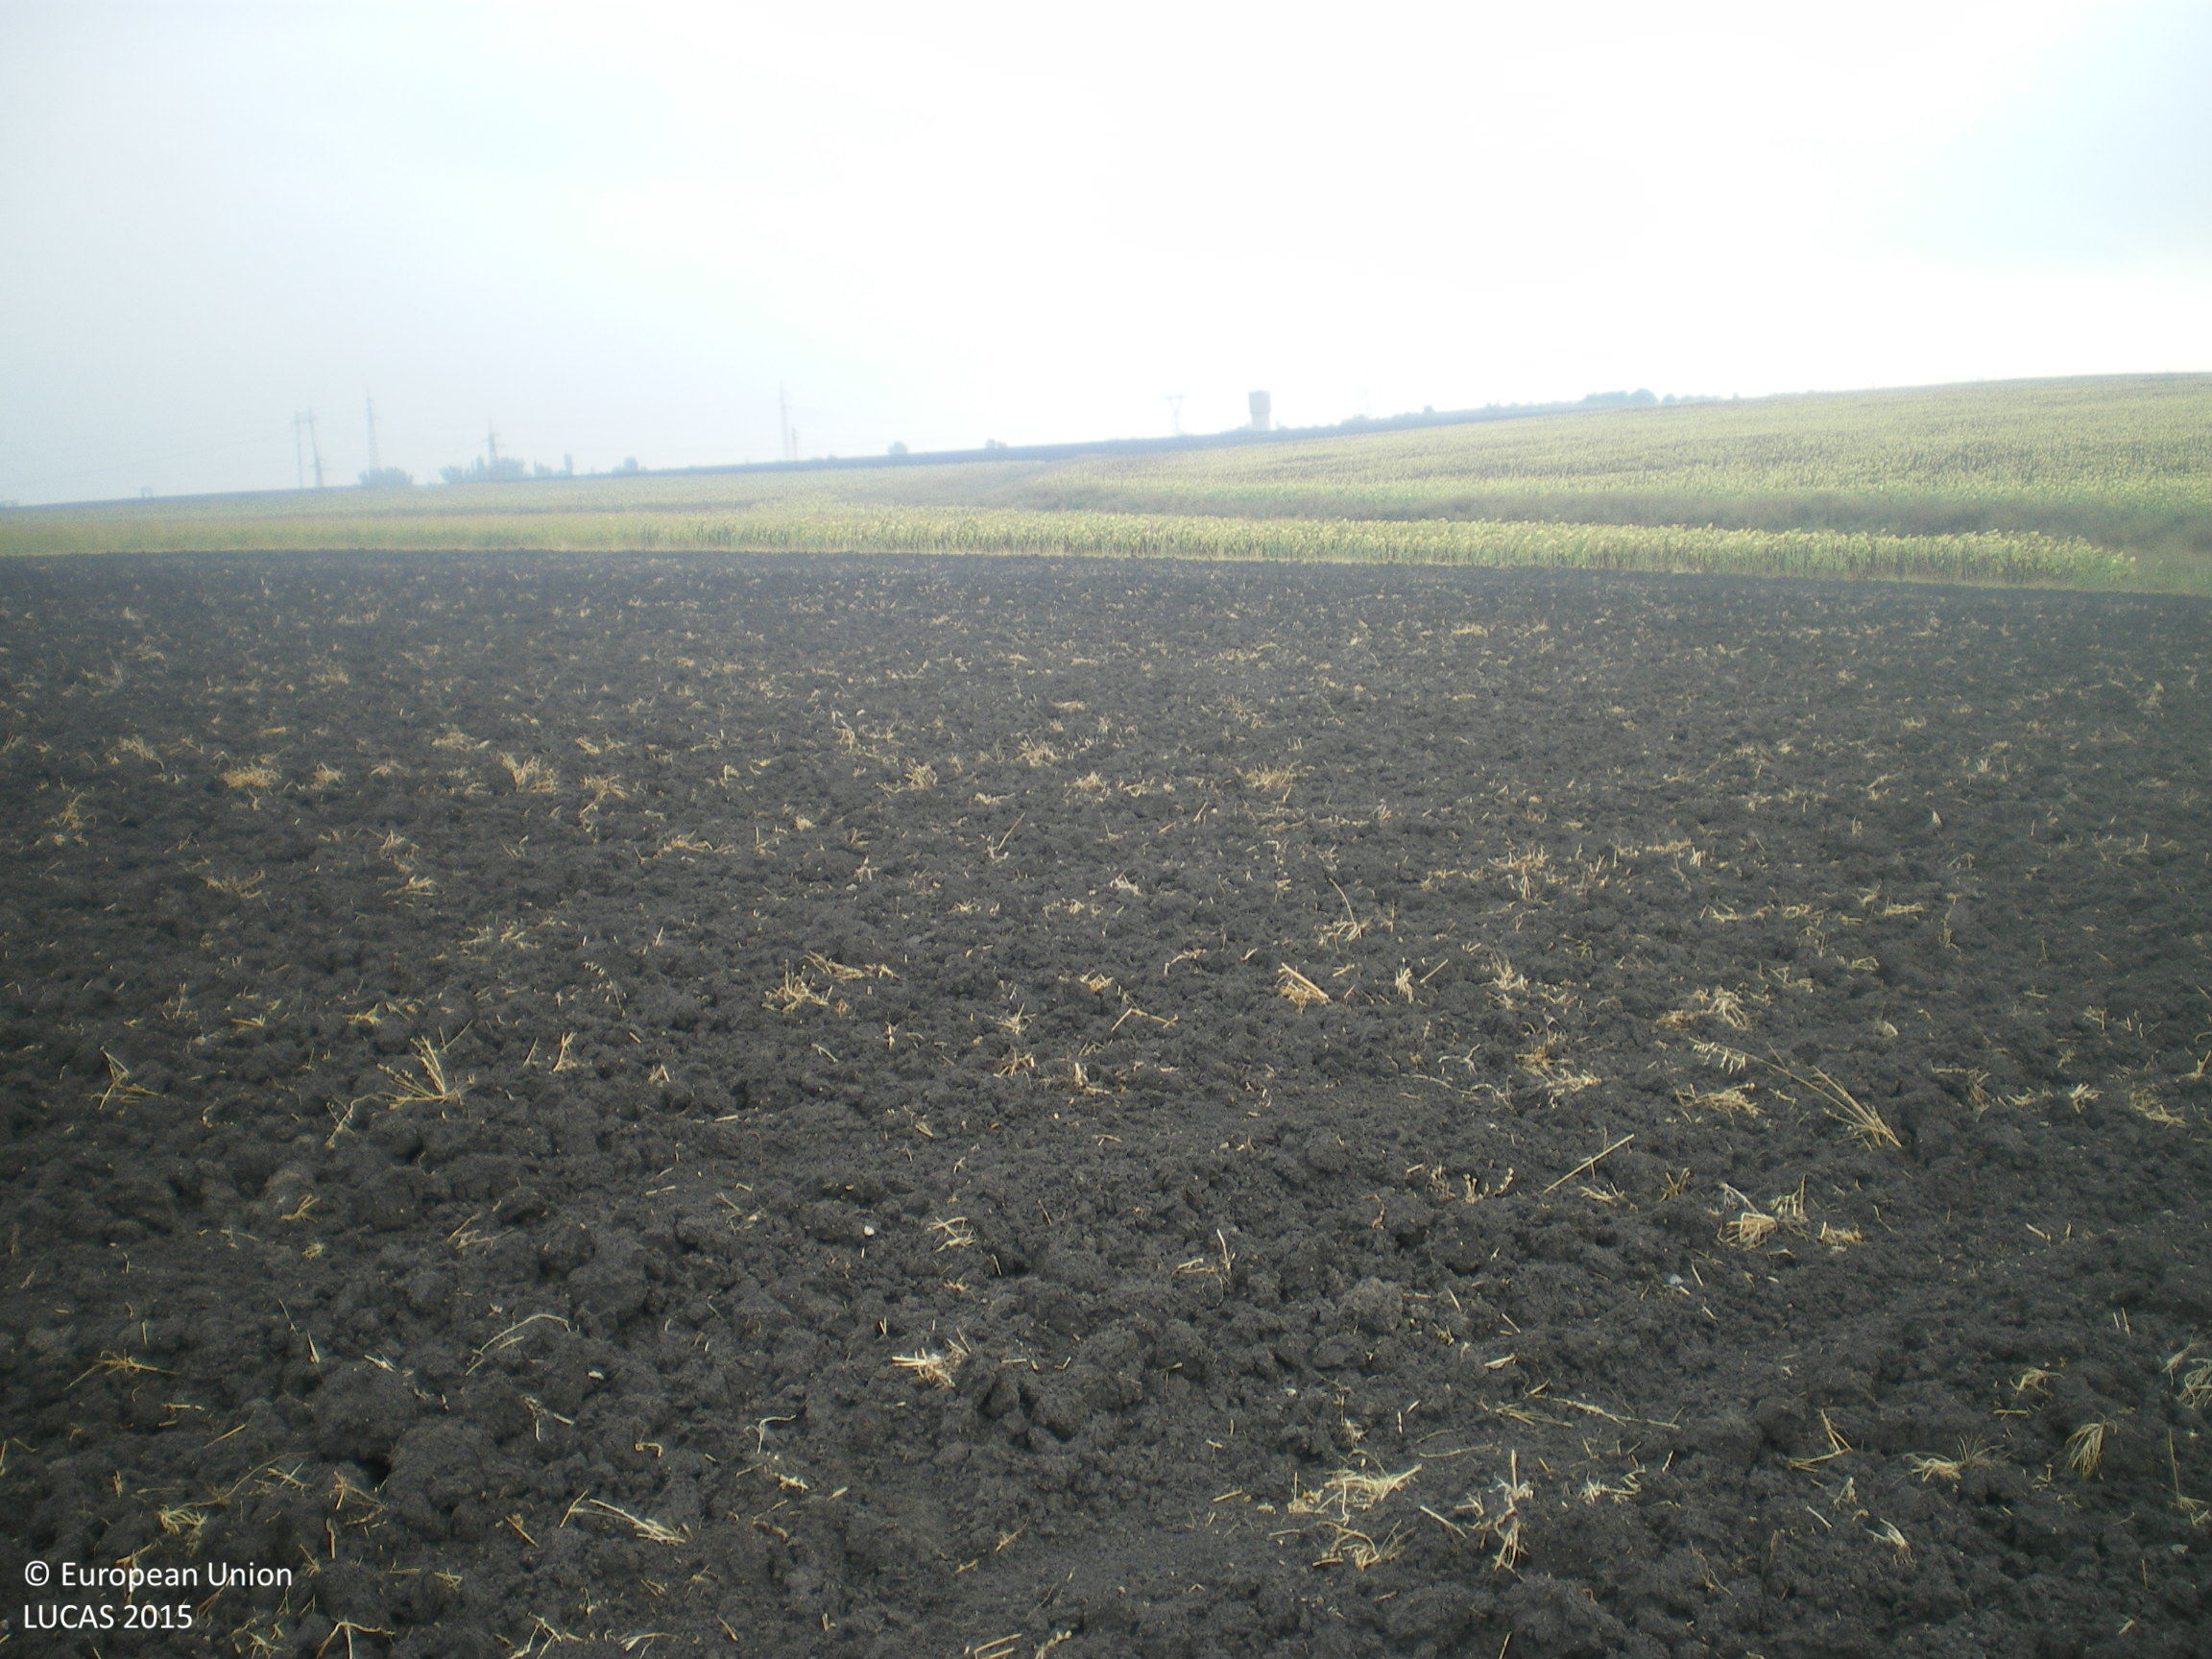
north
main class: Cropland
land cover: Common wheat
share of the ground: < 10 %
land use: Agriculture (excluding fallow land and kitchen gardens)
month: August
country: BG
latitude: 42.2808
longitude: 25.9502
